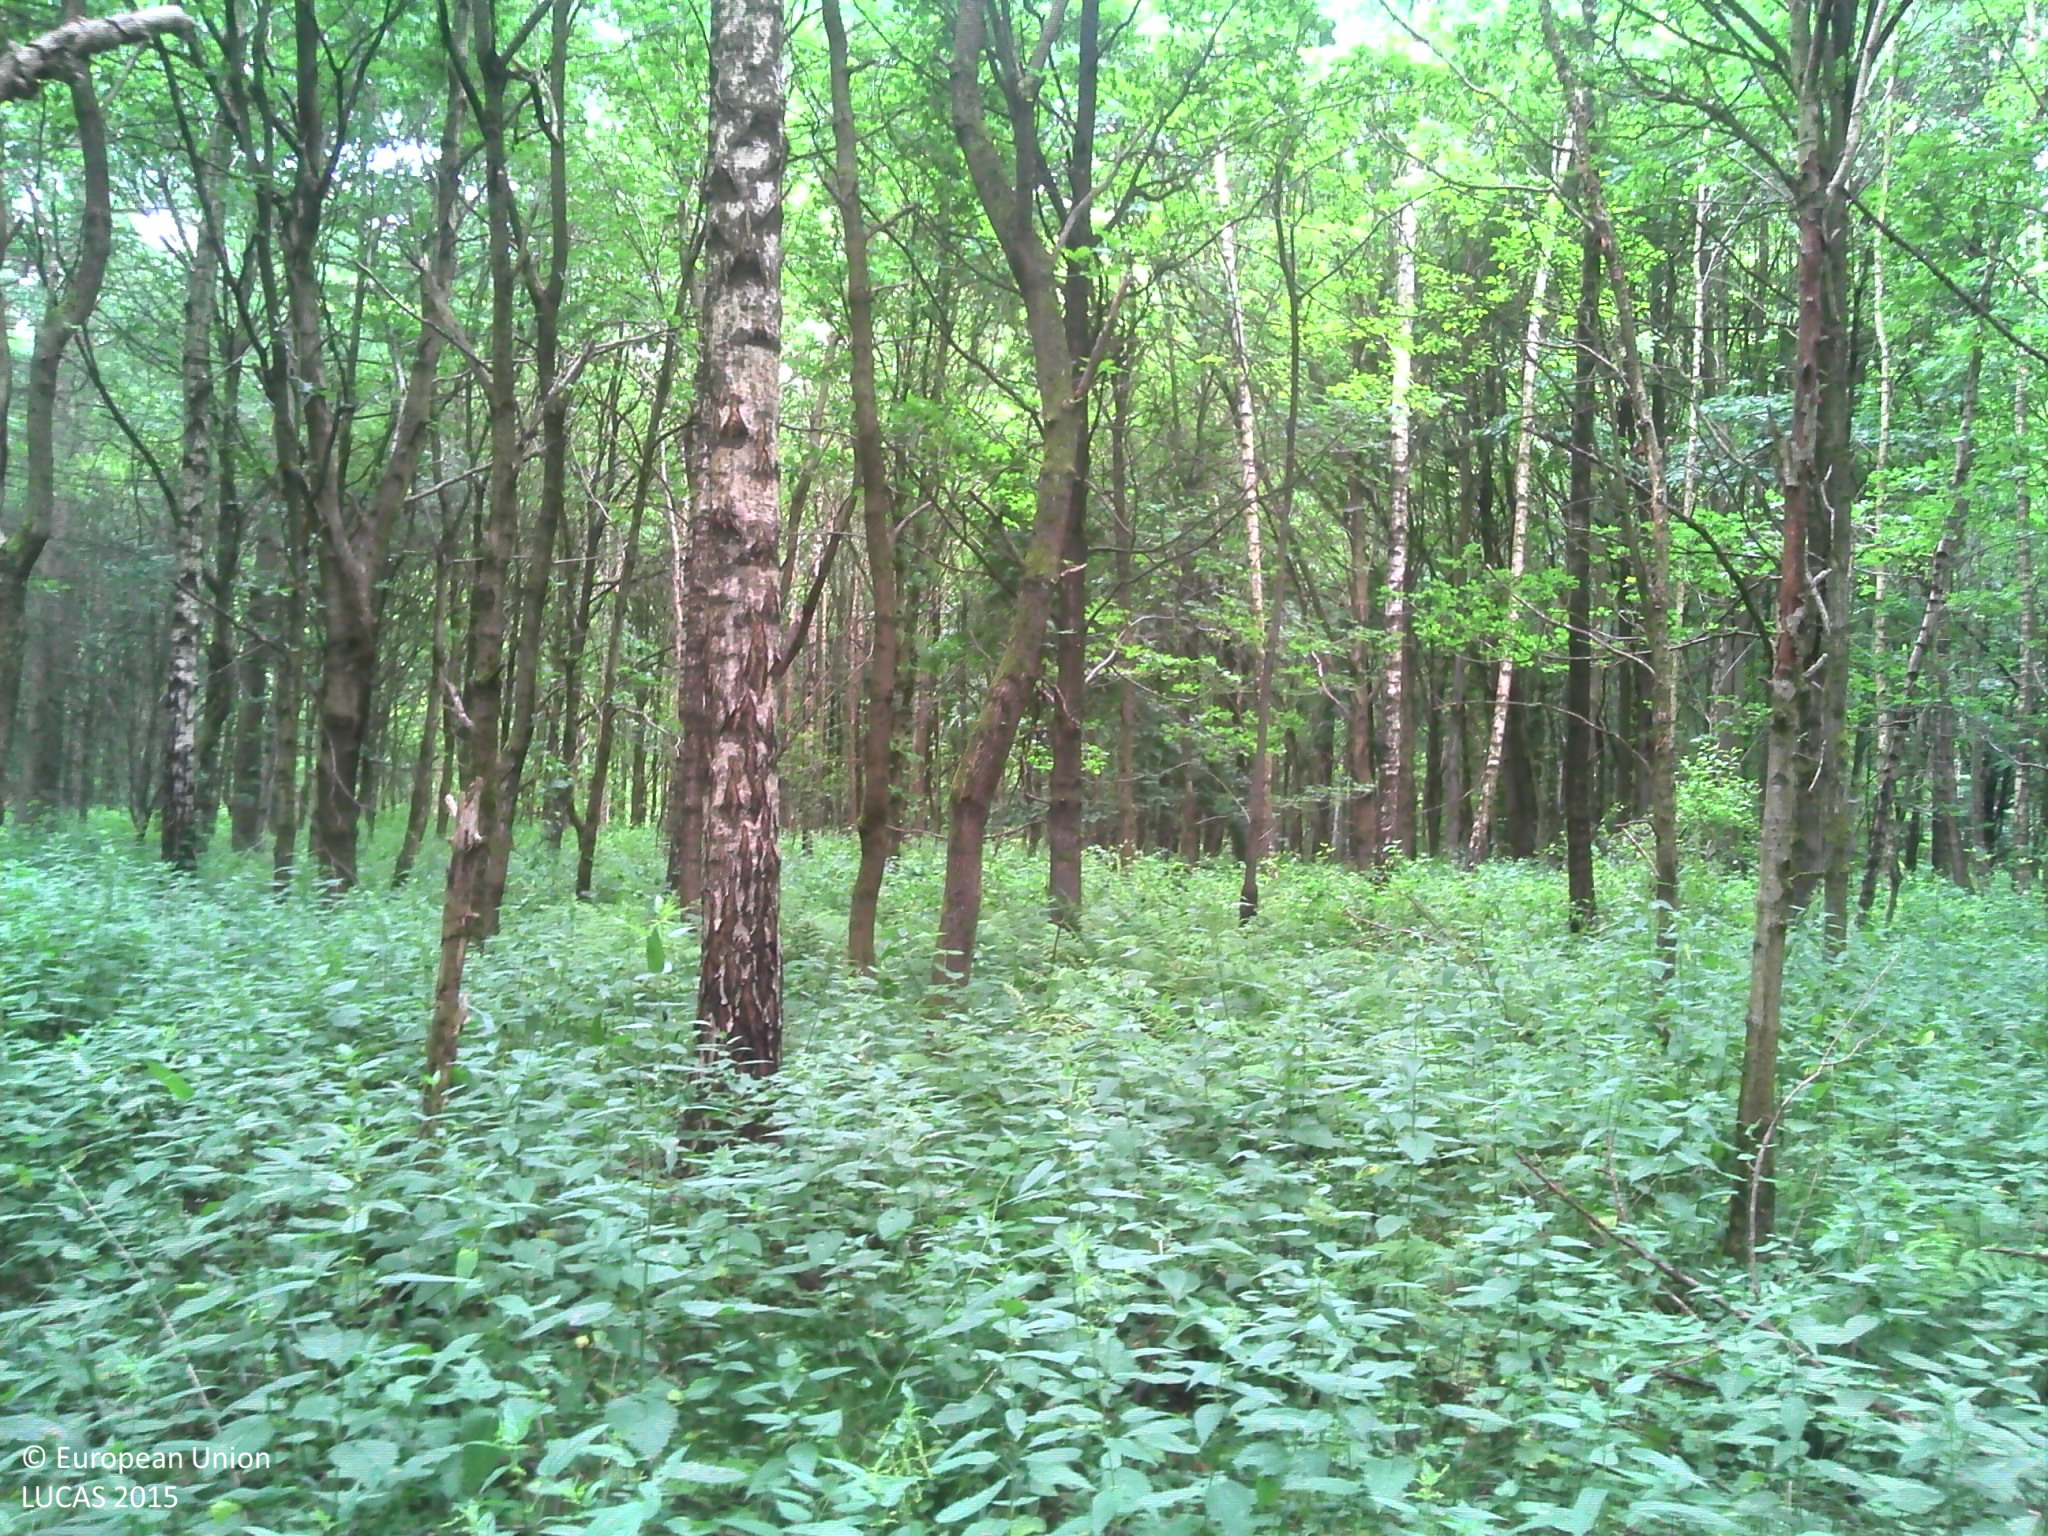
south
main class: Woodland
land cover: Broadleaved woodland
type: acidophilous oak and oak-birch forest
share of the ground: > 75 %
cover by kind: broadleaved forest trees 85 %, coniferous forest trees 5 %, shrubs 5 %, herbaceous plants 5 %
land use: Forestry
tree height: > 5 m
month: July
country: BE
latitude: 50.7853
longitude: 4.3927
